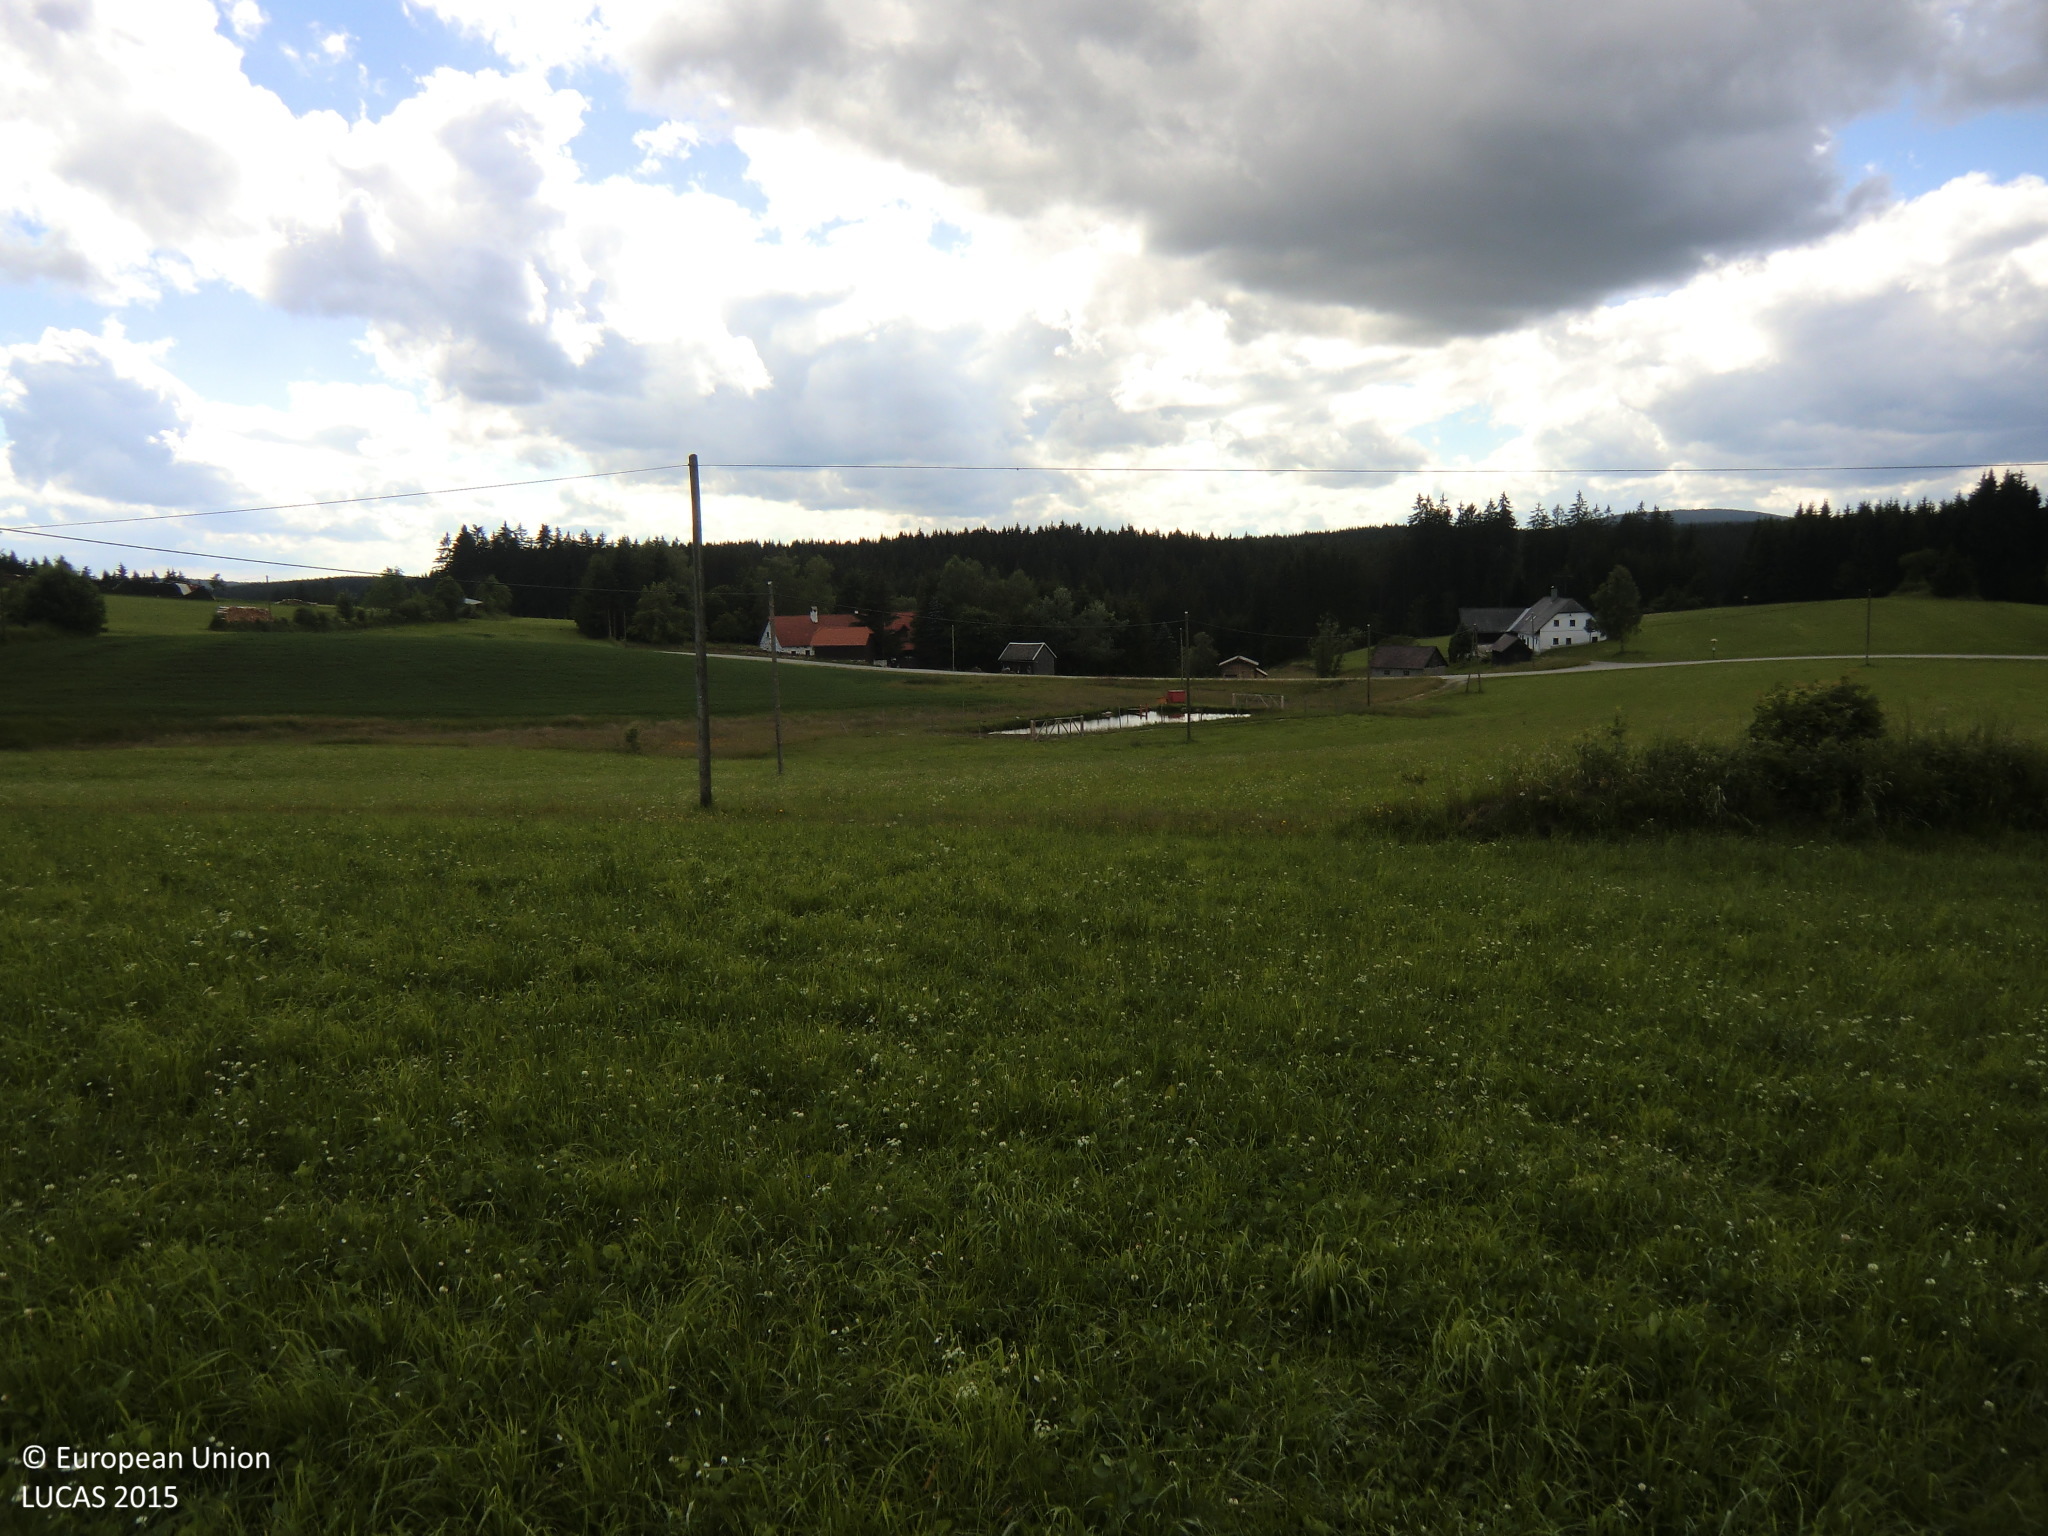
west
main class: Cropland
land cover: Temporary grasslands
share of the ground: 50 - 75 %
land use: Agriculture (excluding fallow land and kitchen gardens)
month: June
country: AT
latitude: 48.5367
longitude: 14.7278
